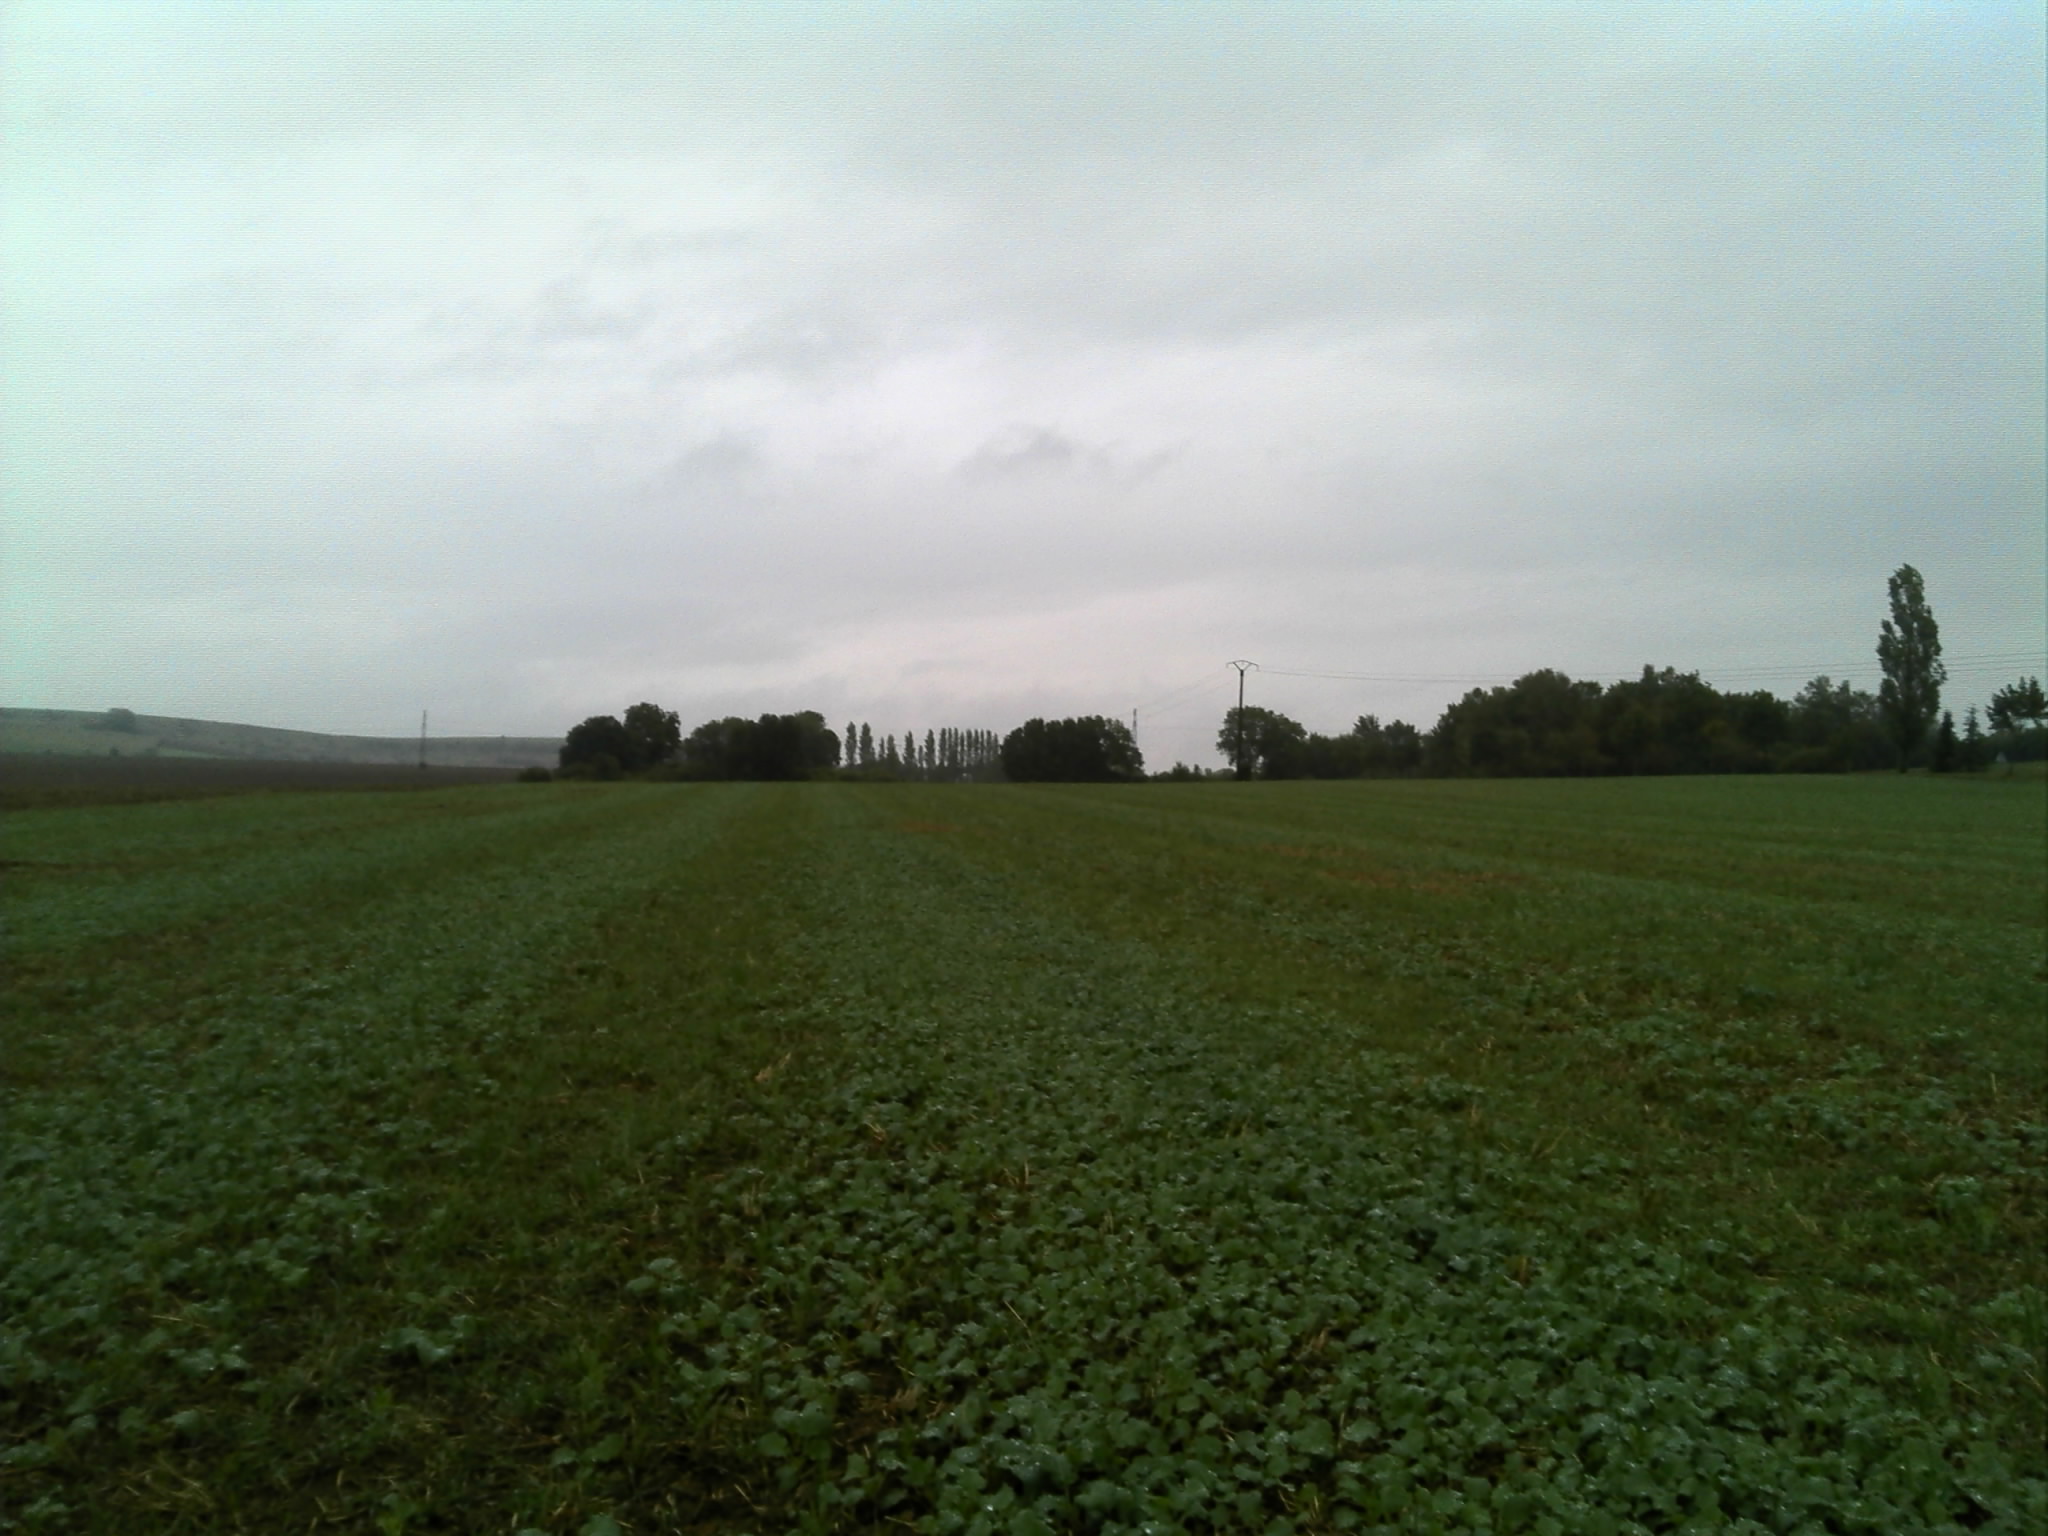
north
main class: Cropland
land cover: Rape and turnip rape
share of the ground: < 10 %
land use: Agriculture (excluding fallow land and kitchen gardens)
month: September
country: FR
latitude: 49.3367
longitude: 5.9119
